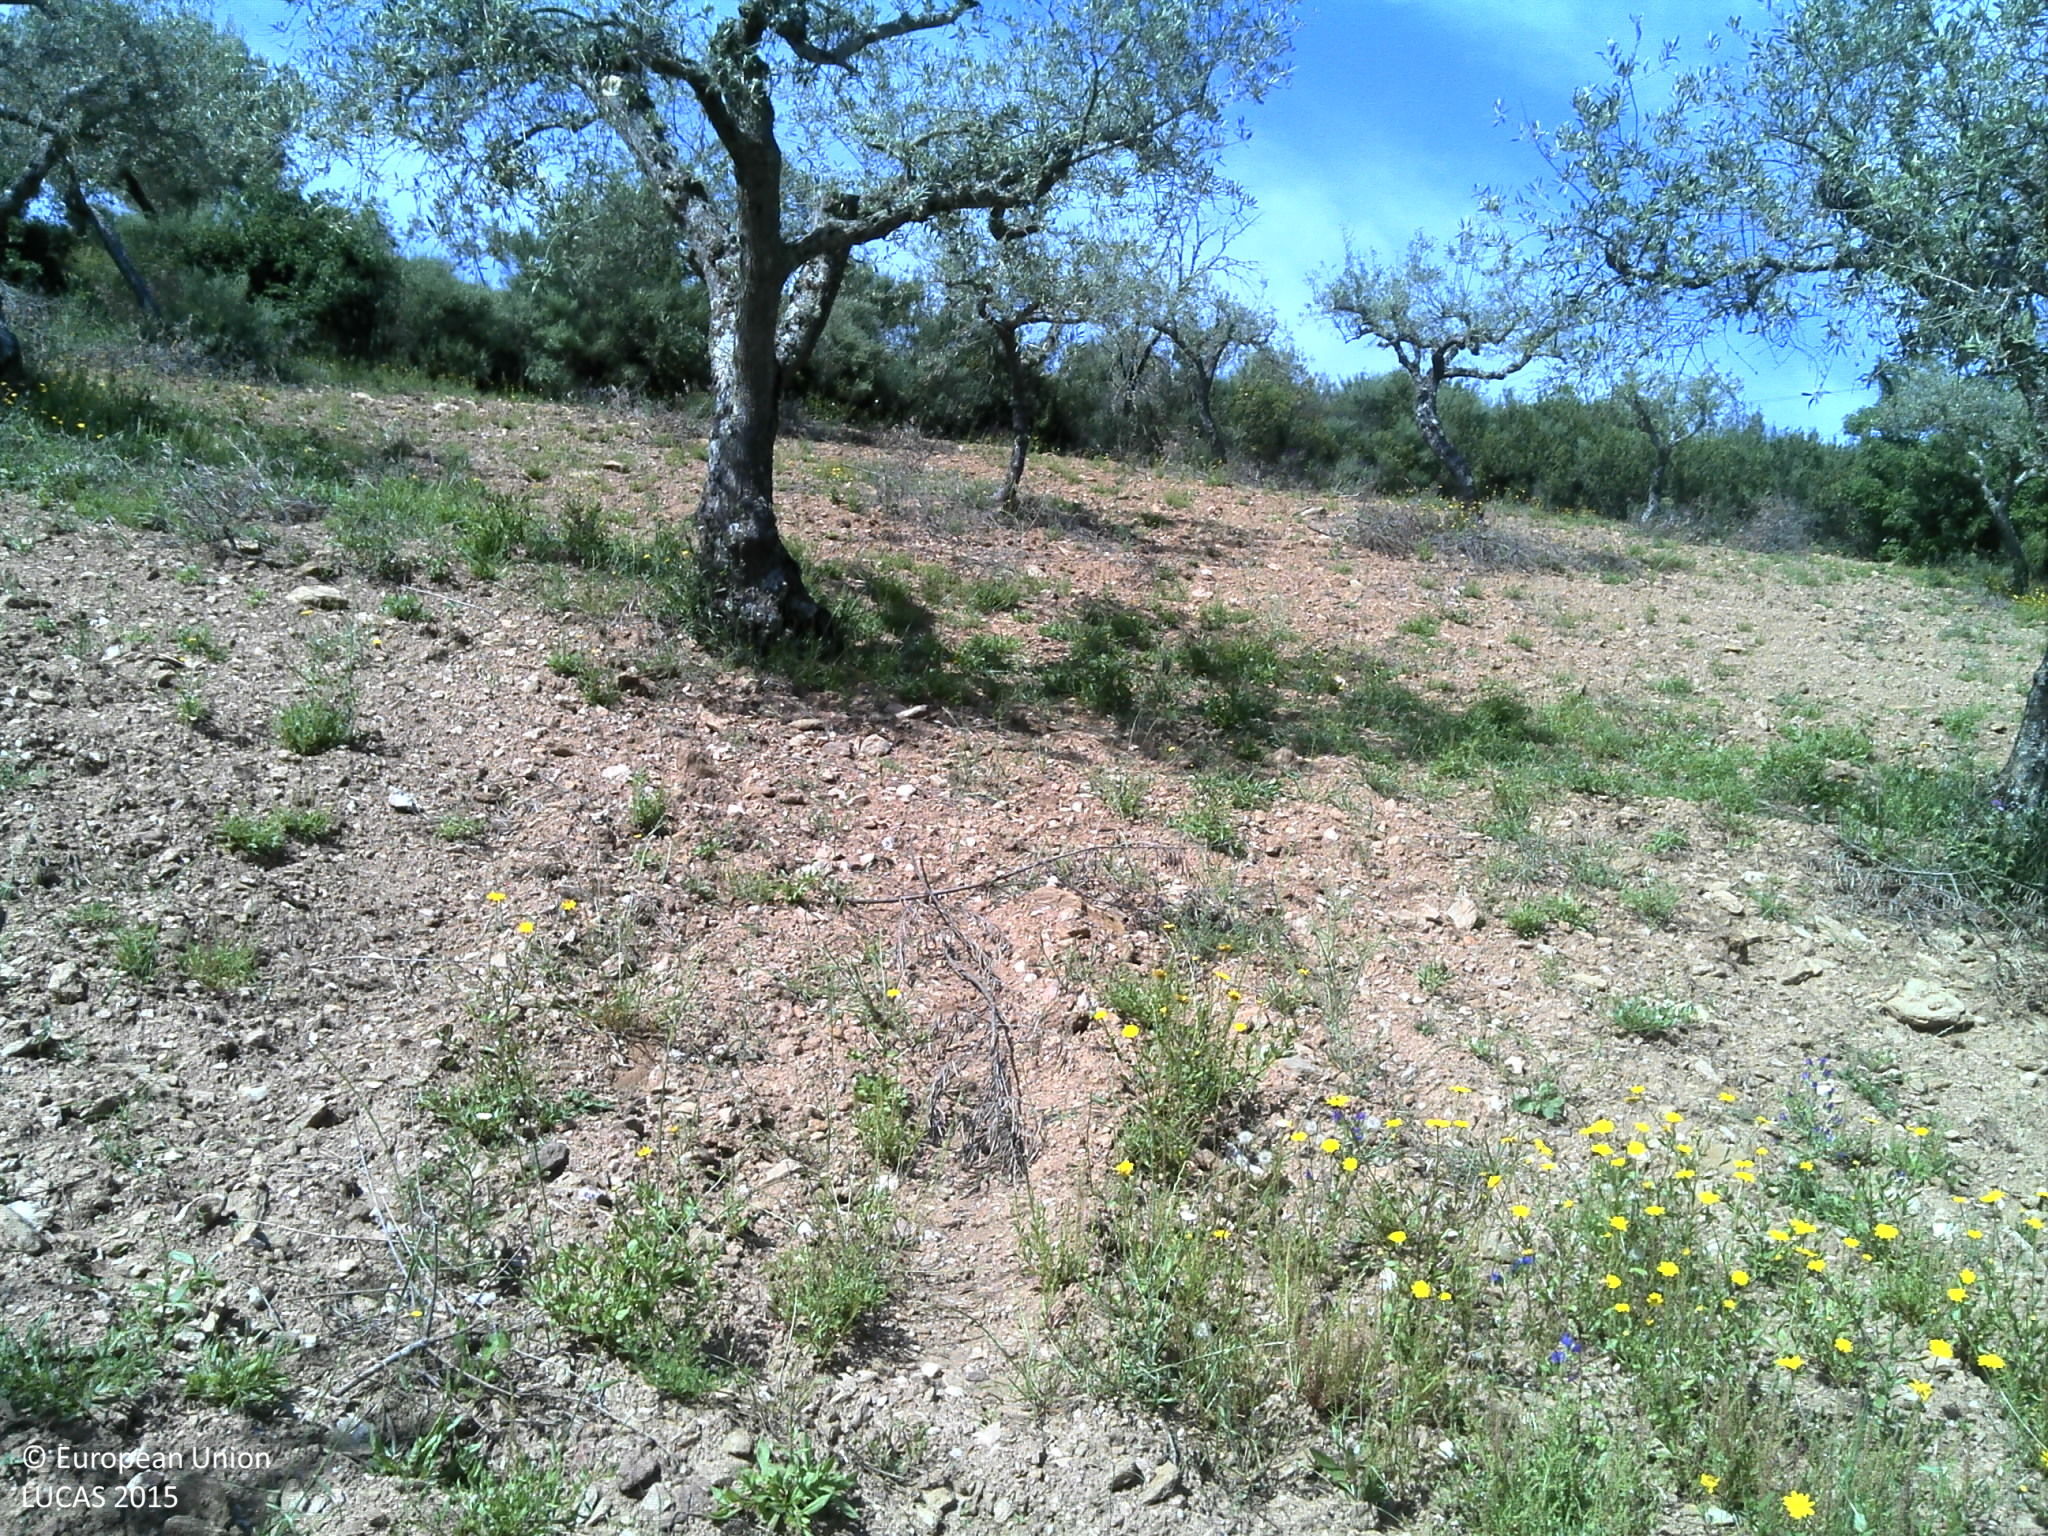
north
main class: Cropland
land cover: Olive groves
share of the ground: 25 - 50 %
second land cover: Spontaneously vegetated surfaces
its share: 10 - 25 %
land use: Agriculture (excluding fallow land and kitchen gardens)
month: May
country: PT
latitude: 41.5800
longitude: -7.0652
